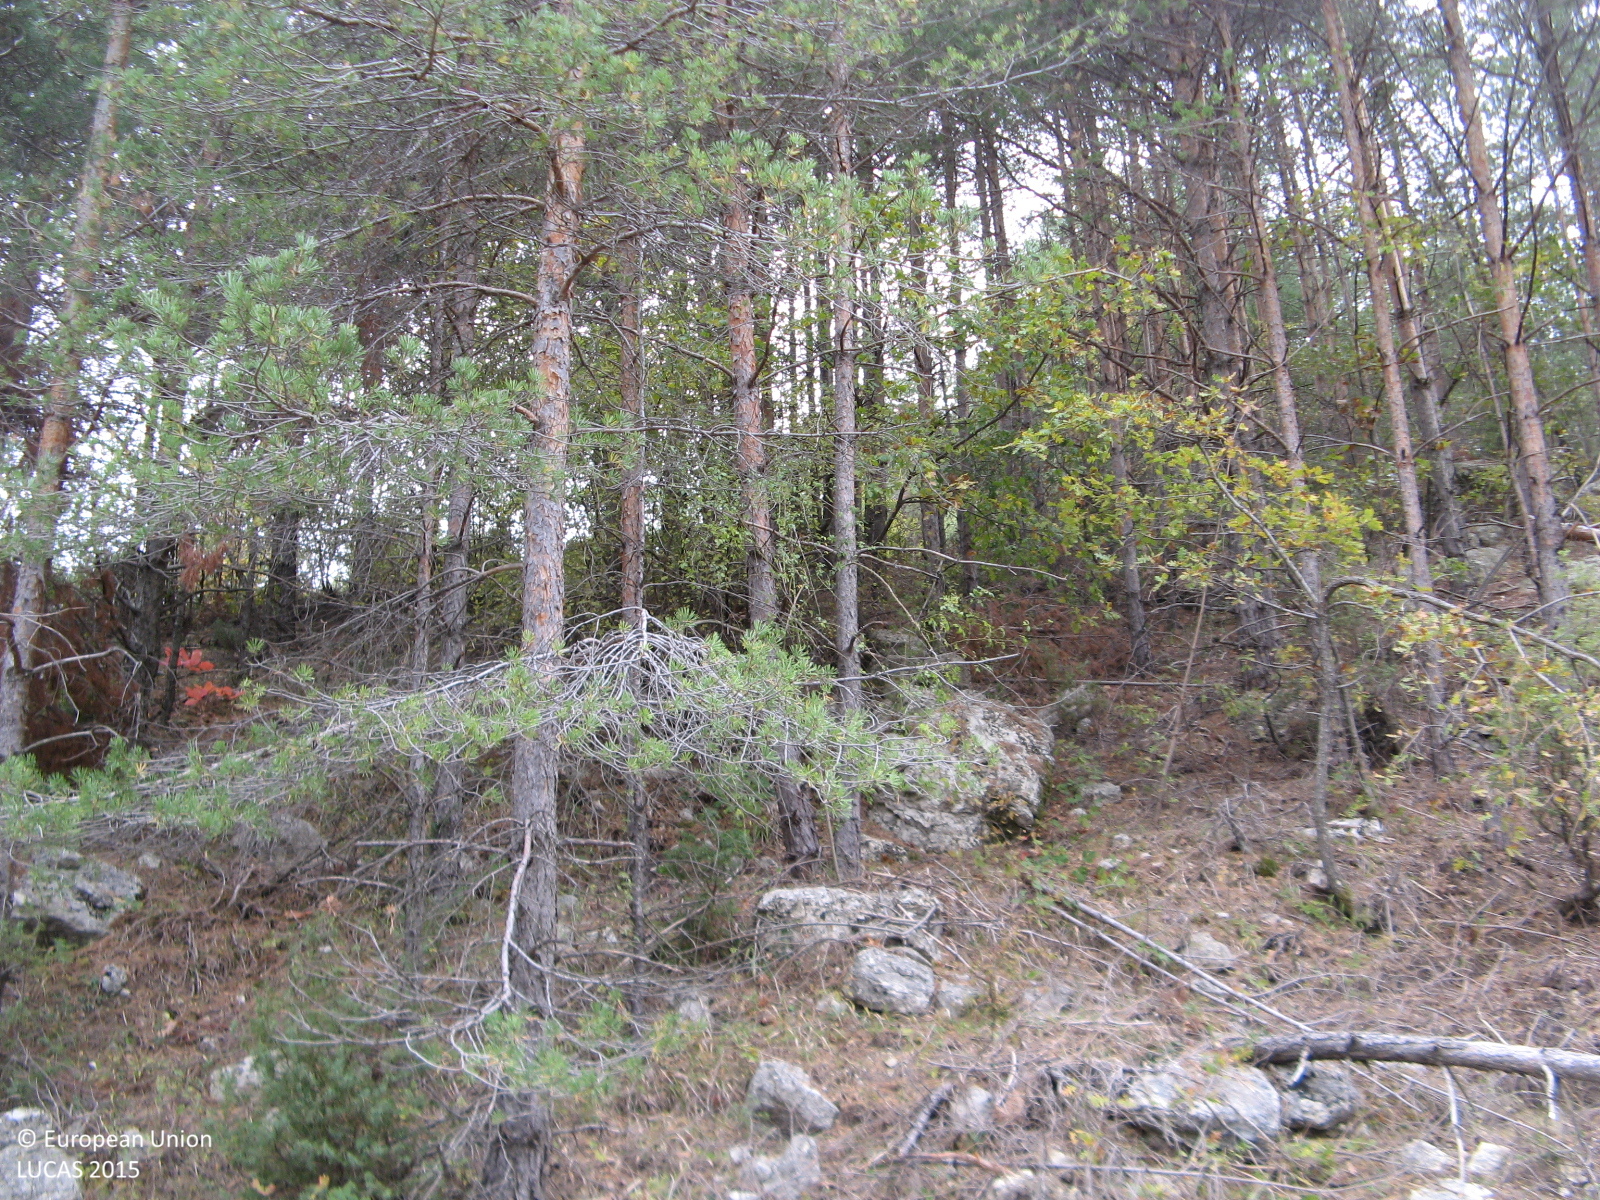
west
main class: Woodland
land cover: Pine dominated mixed woodland
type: hemiboreal forest and nemoral coniferous forest and mixed broadleaved-coniferous forest
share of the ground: > 75 %
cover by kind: coniferous forest trees 75 %, broadleaved forest trees 25 %
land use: Forestry
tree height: > 5 m
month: November
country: BG
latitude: 41.4167
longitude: 25.2582
